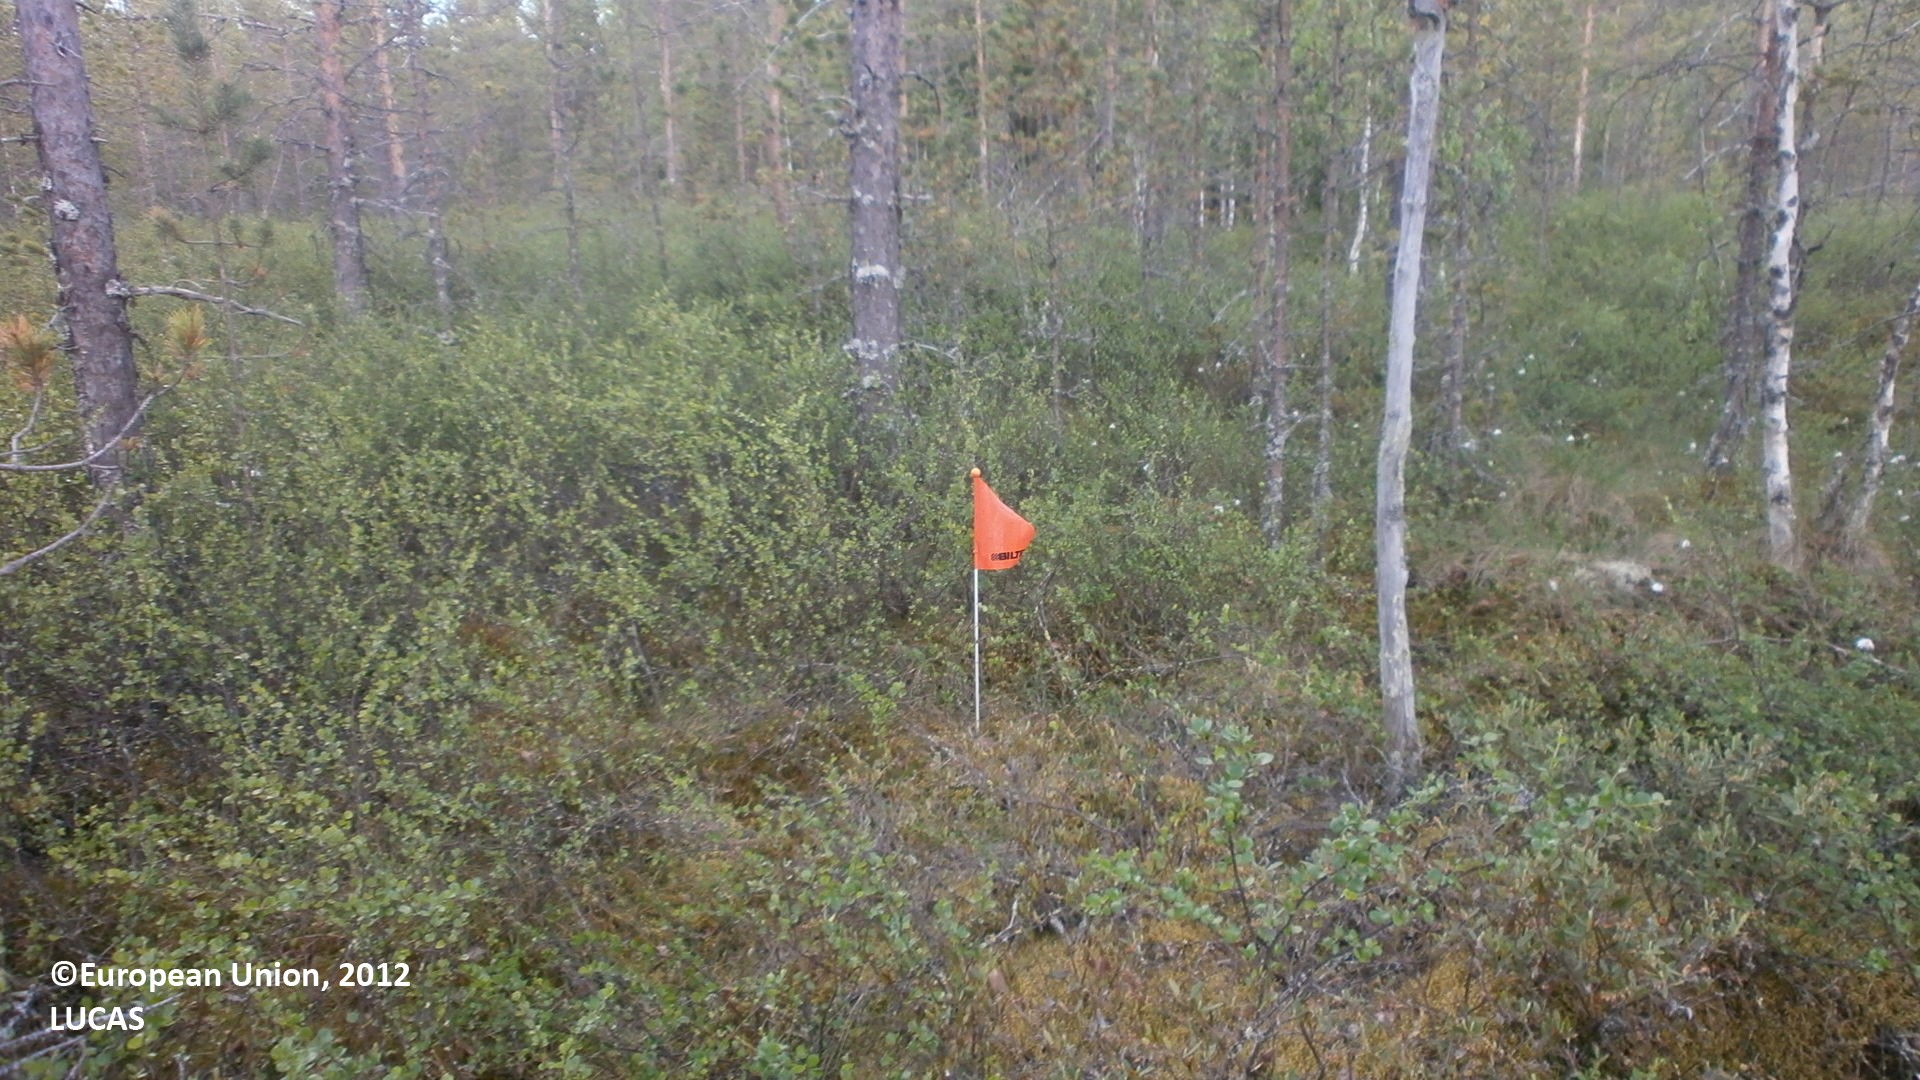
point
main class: Woodland
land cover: Pine dominated coniferous woodland
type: mire and swamp forests
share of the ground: 25 - 50 %
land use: Forestry
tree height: > 5 m
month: June
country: FI
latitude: 64.0503
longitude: 25.7289
